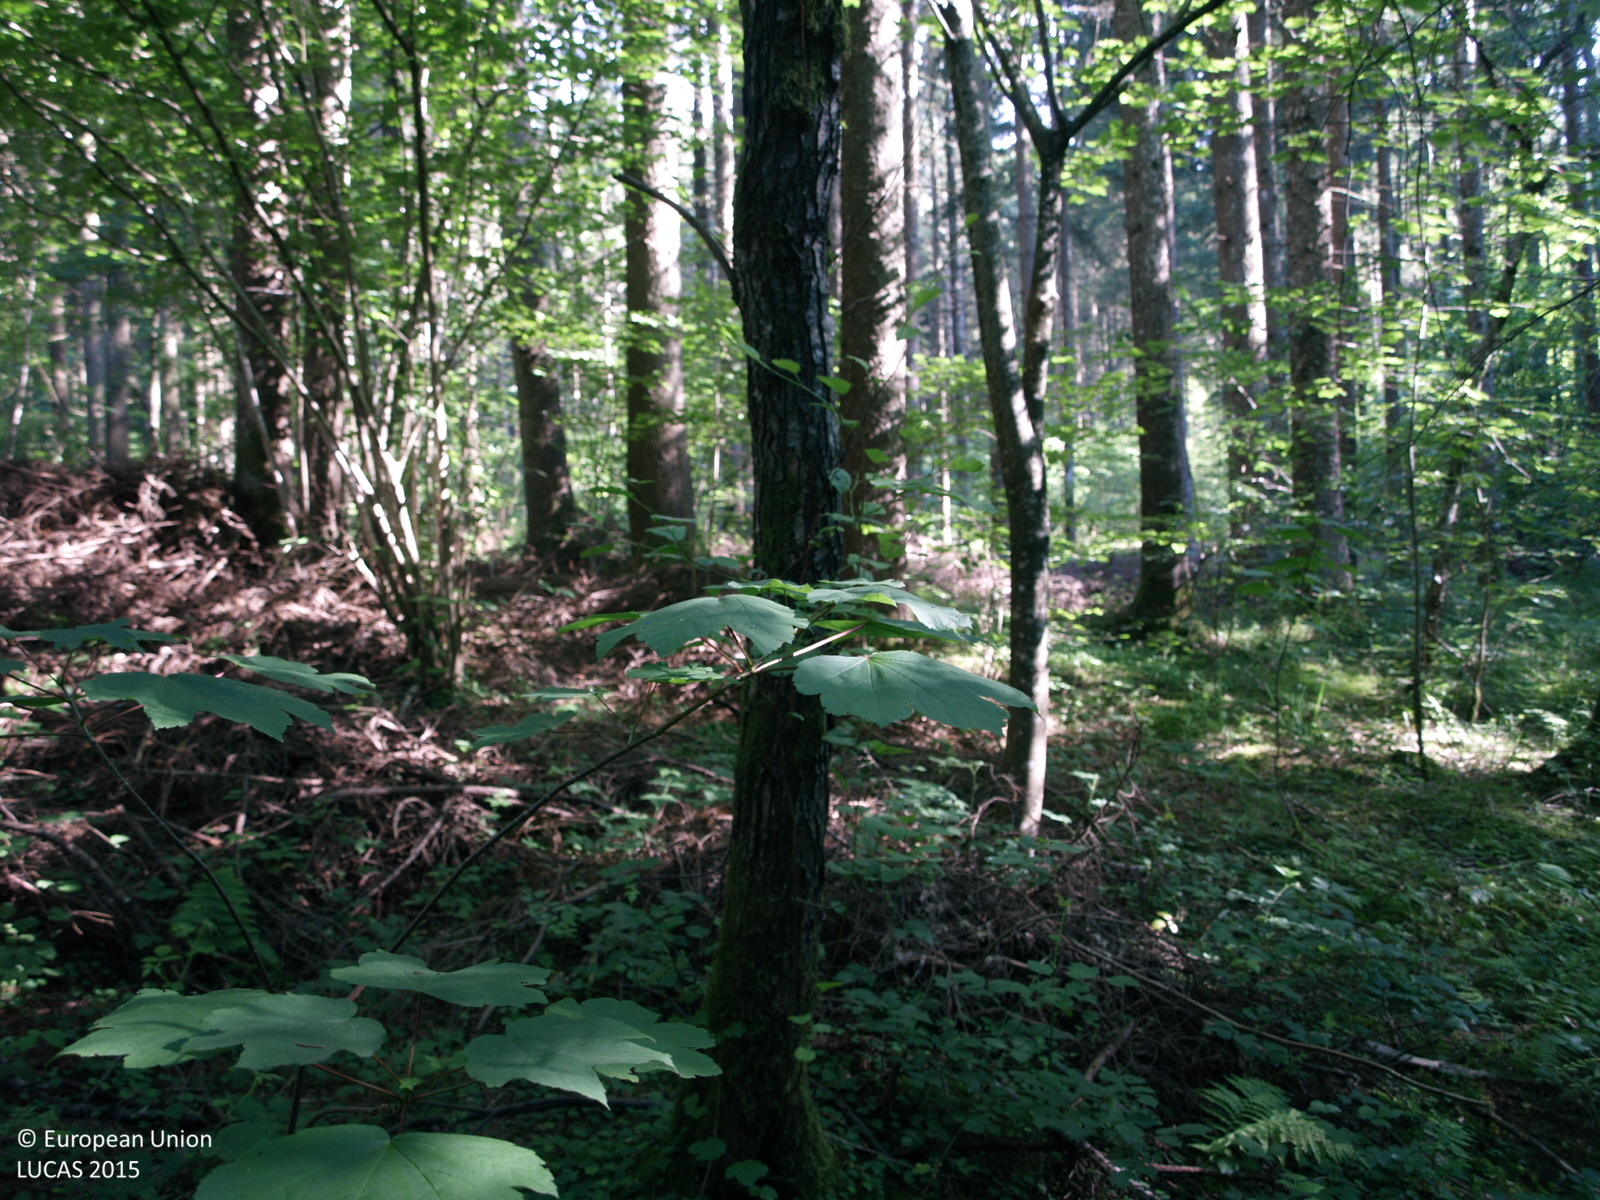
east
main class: Woodland
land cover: Other mixed woodland
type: alpine coniferous forest
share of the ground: > 75 %
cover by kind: broadleaved forest trees 60 %, coniferous forest trees 40 %
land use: Forestry
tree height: > 5 m
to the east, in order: Other mixed woodland; Grassland with sparse tree/shrub cover; Paved roads, cycling and walking lanes; Other mixed woodland; Broadleaved woodland; Tracks; Broadleaved woodland; Tracks; Grassland with sparse tree/shrub cover; Shrubland with sparse tree cover
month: May
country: IT
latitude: 46.0504
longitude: 11.6391
